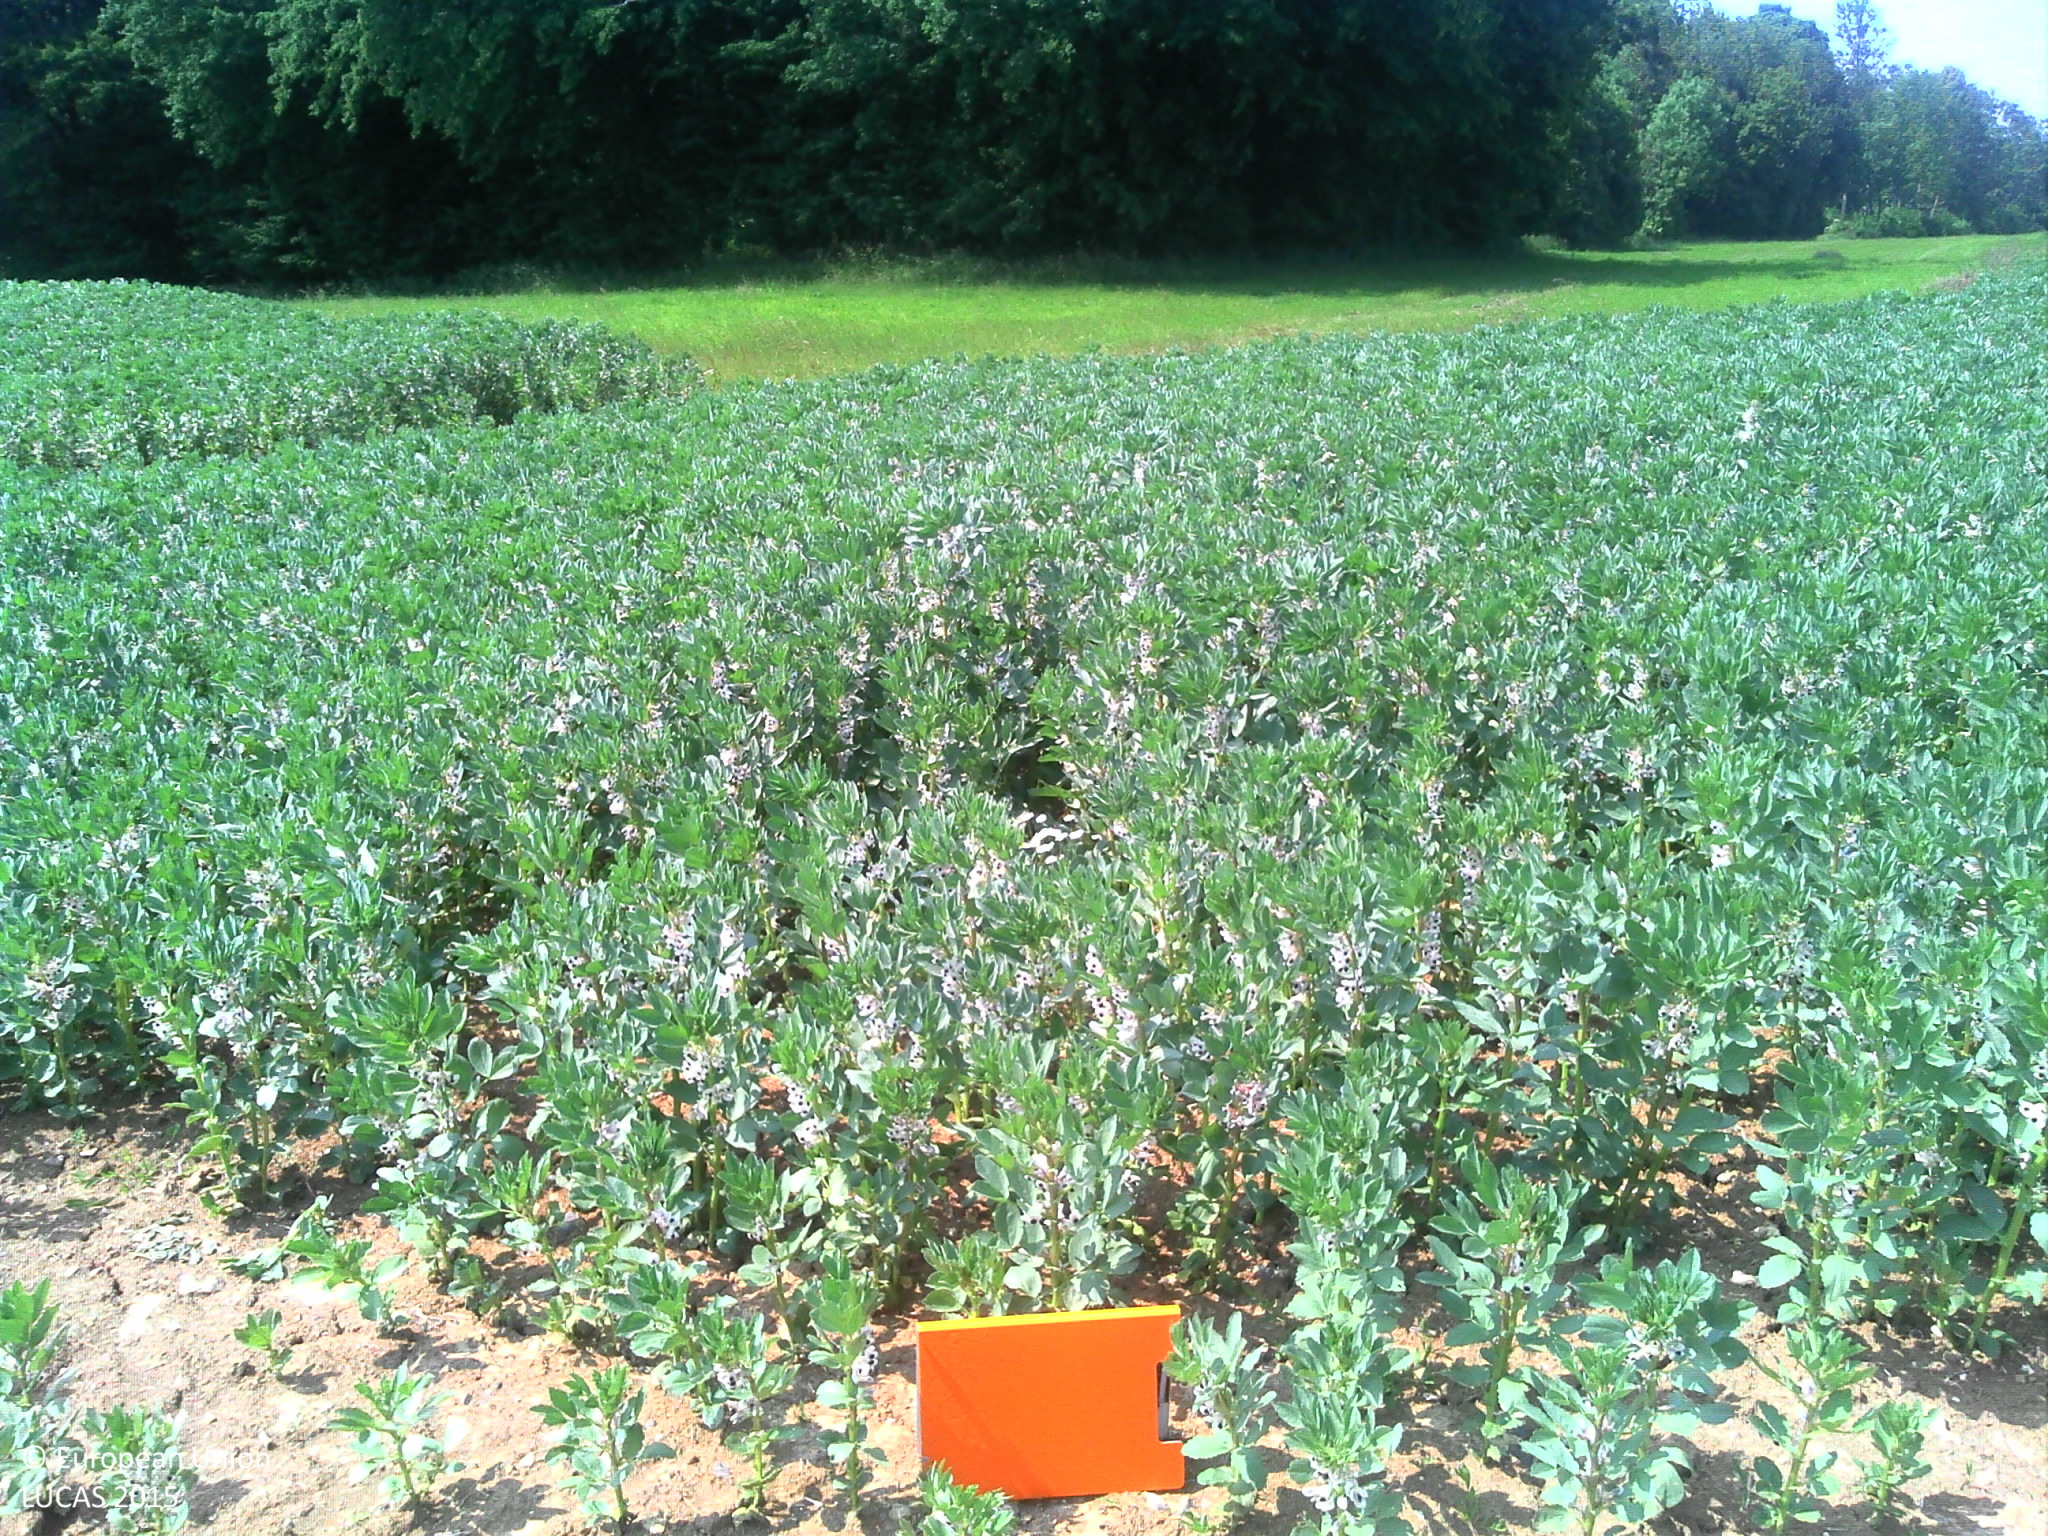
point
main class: Cropland
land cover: Dry pulses
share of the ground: > 75 %
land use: Agriculture (excluding fallow land and kitchen gardens)
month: June
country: FR
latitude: 49.7249
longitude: 4.0993
